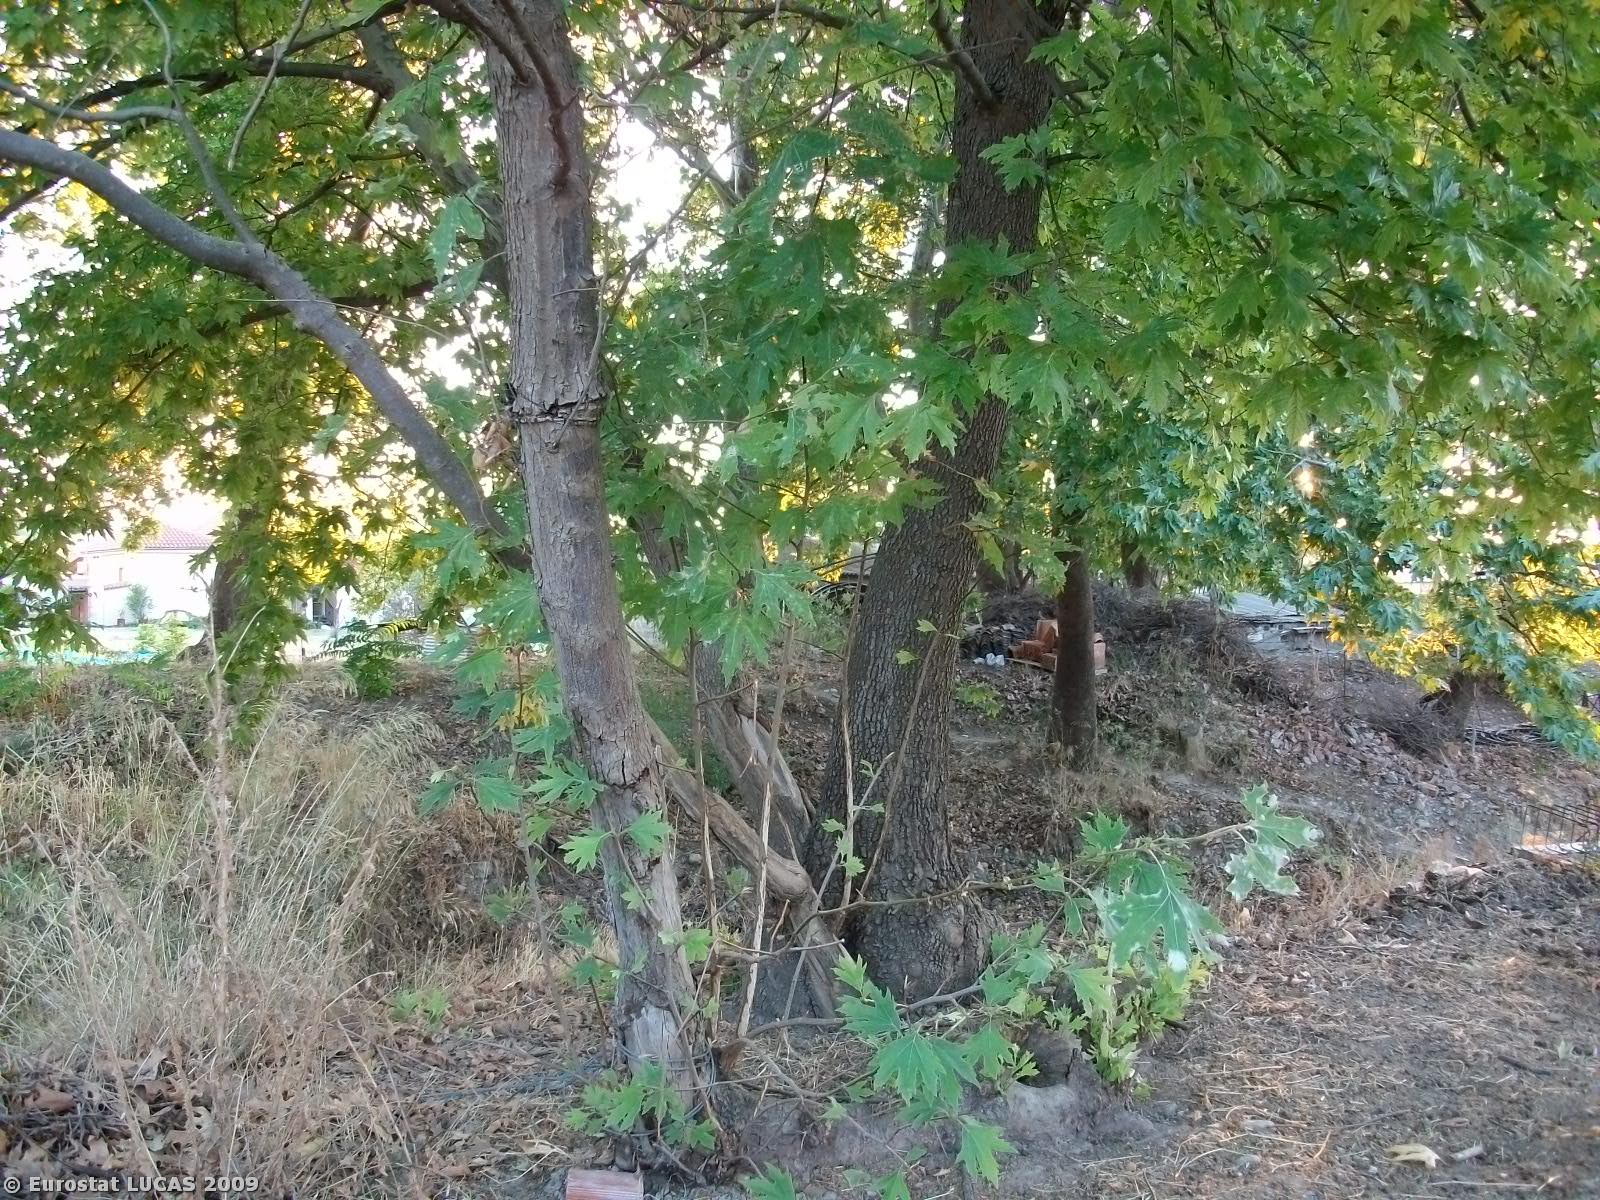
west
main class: Shrubland
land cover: Shrubland with sparse tree cover
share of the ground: 50 - 75 %
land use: Unused
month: August
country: GR
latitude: 38.9352
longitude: 23.1740
